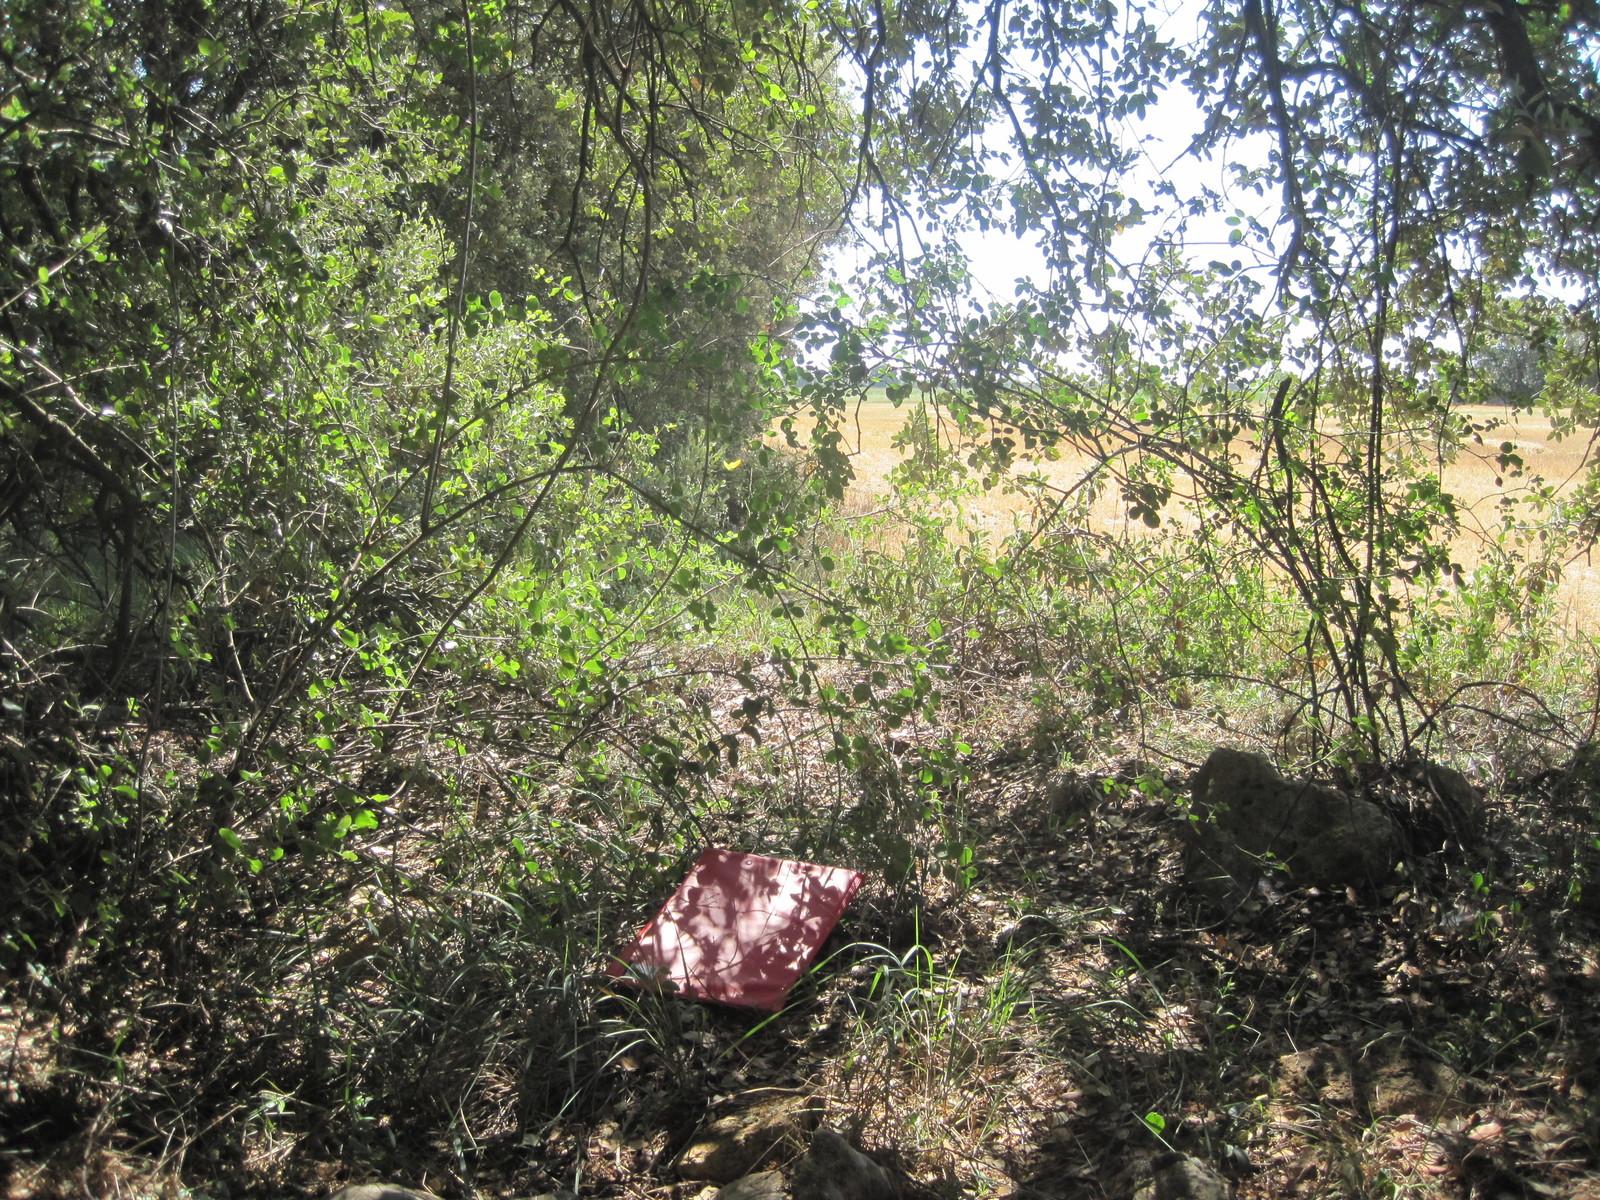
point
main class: Woodland
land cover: Broadleaved woodland
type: thermophilous deciduous forest
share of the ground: > 75 %
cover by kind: broadleaved forest trees 75 %, herbaceous plants 25 %
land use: Forestry
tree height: > 5 m
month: July
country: ES
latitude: 41.8913
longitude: -4.6664
